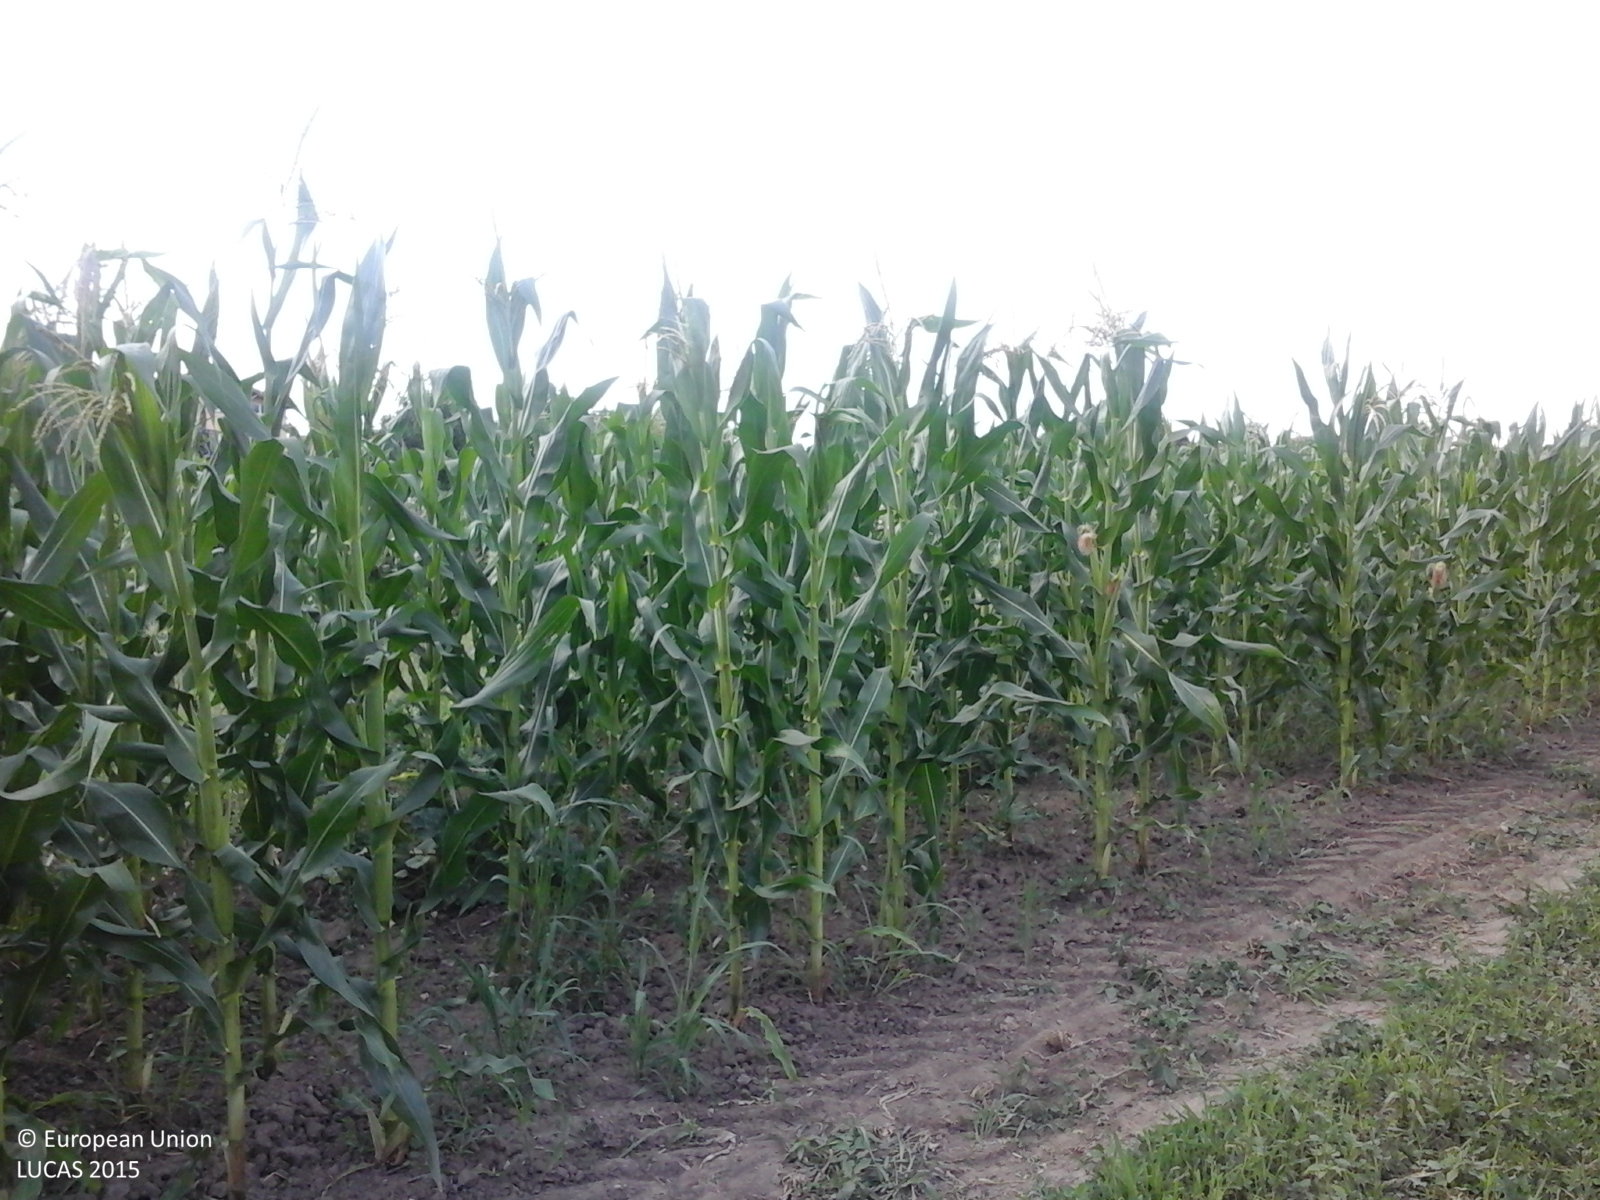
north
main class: Cropland
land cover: Maize
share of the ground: > 75 %
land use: Agriculture (excluding fallow land and kitchen gardens)
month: June
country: RO
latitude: 44.3175
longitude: 26.1923
